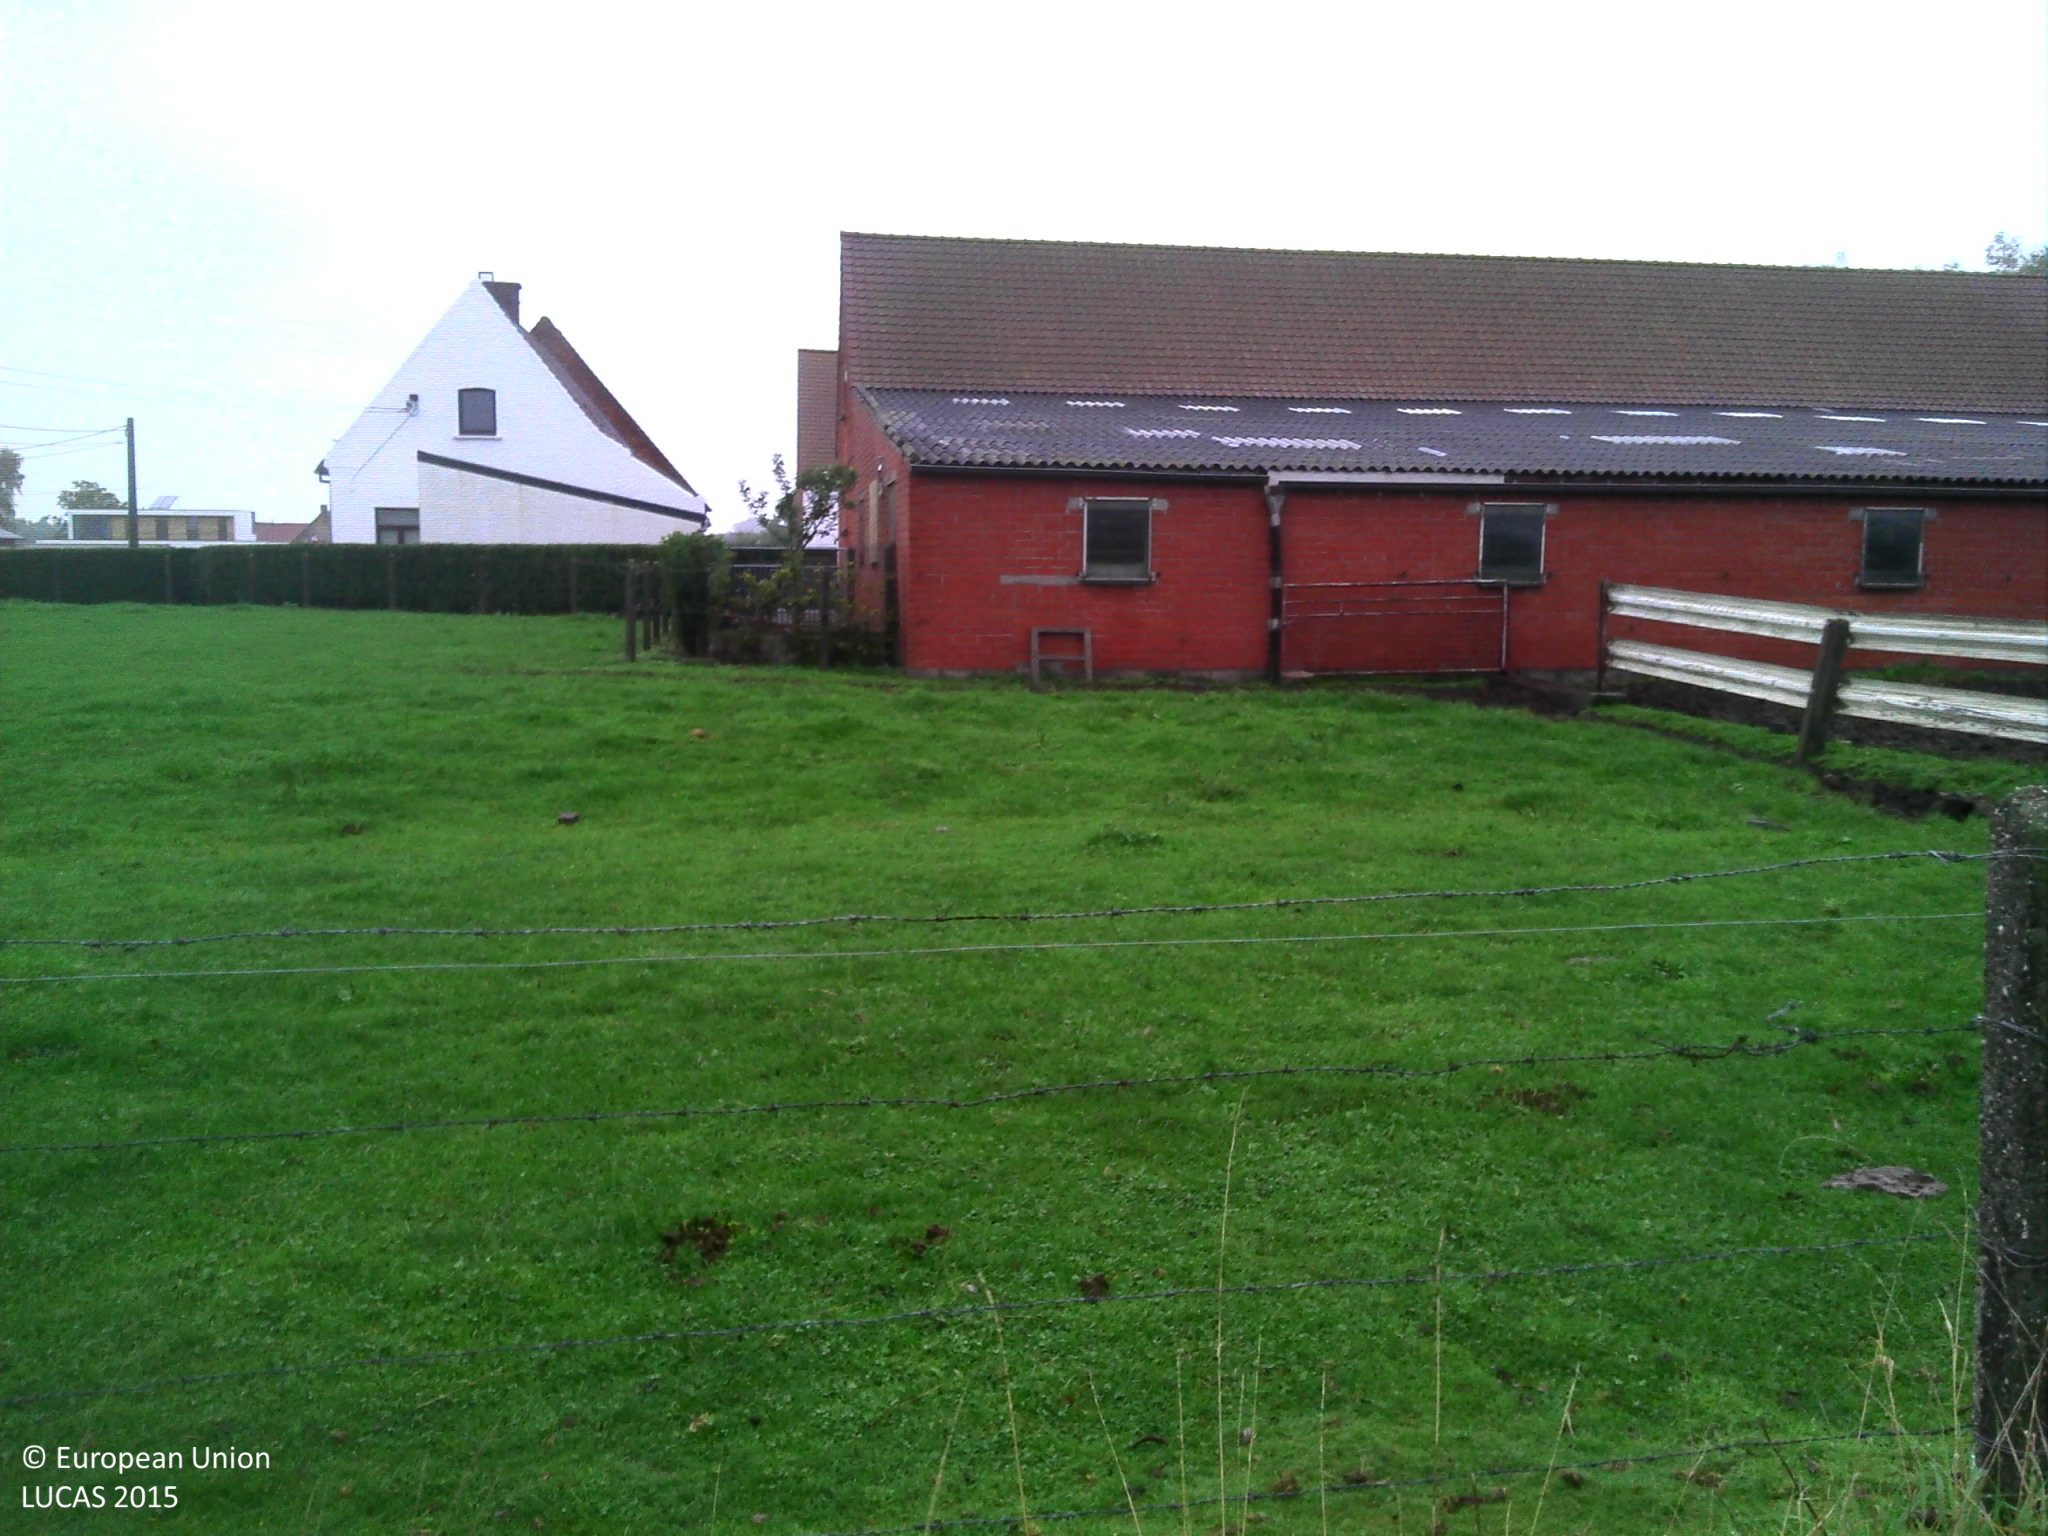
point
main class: Grassland
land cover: Grassland without tree/shrub cover
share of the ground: > 75 %
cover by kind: herbaceous plants 100 %
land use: Agriculture (excluding fallow land and kitchen gardens)
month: October
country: BE
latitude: 50.9905
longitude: 2.8801
